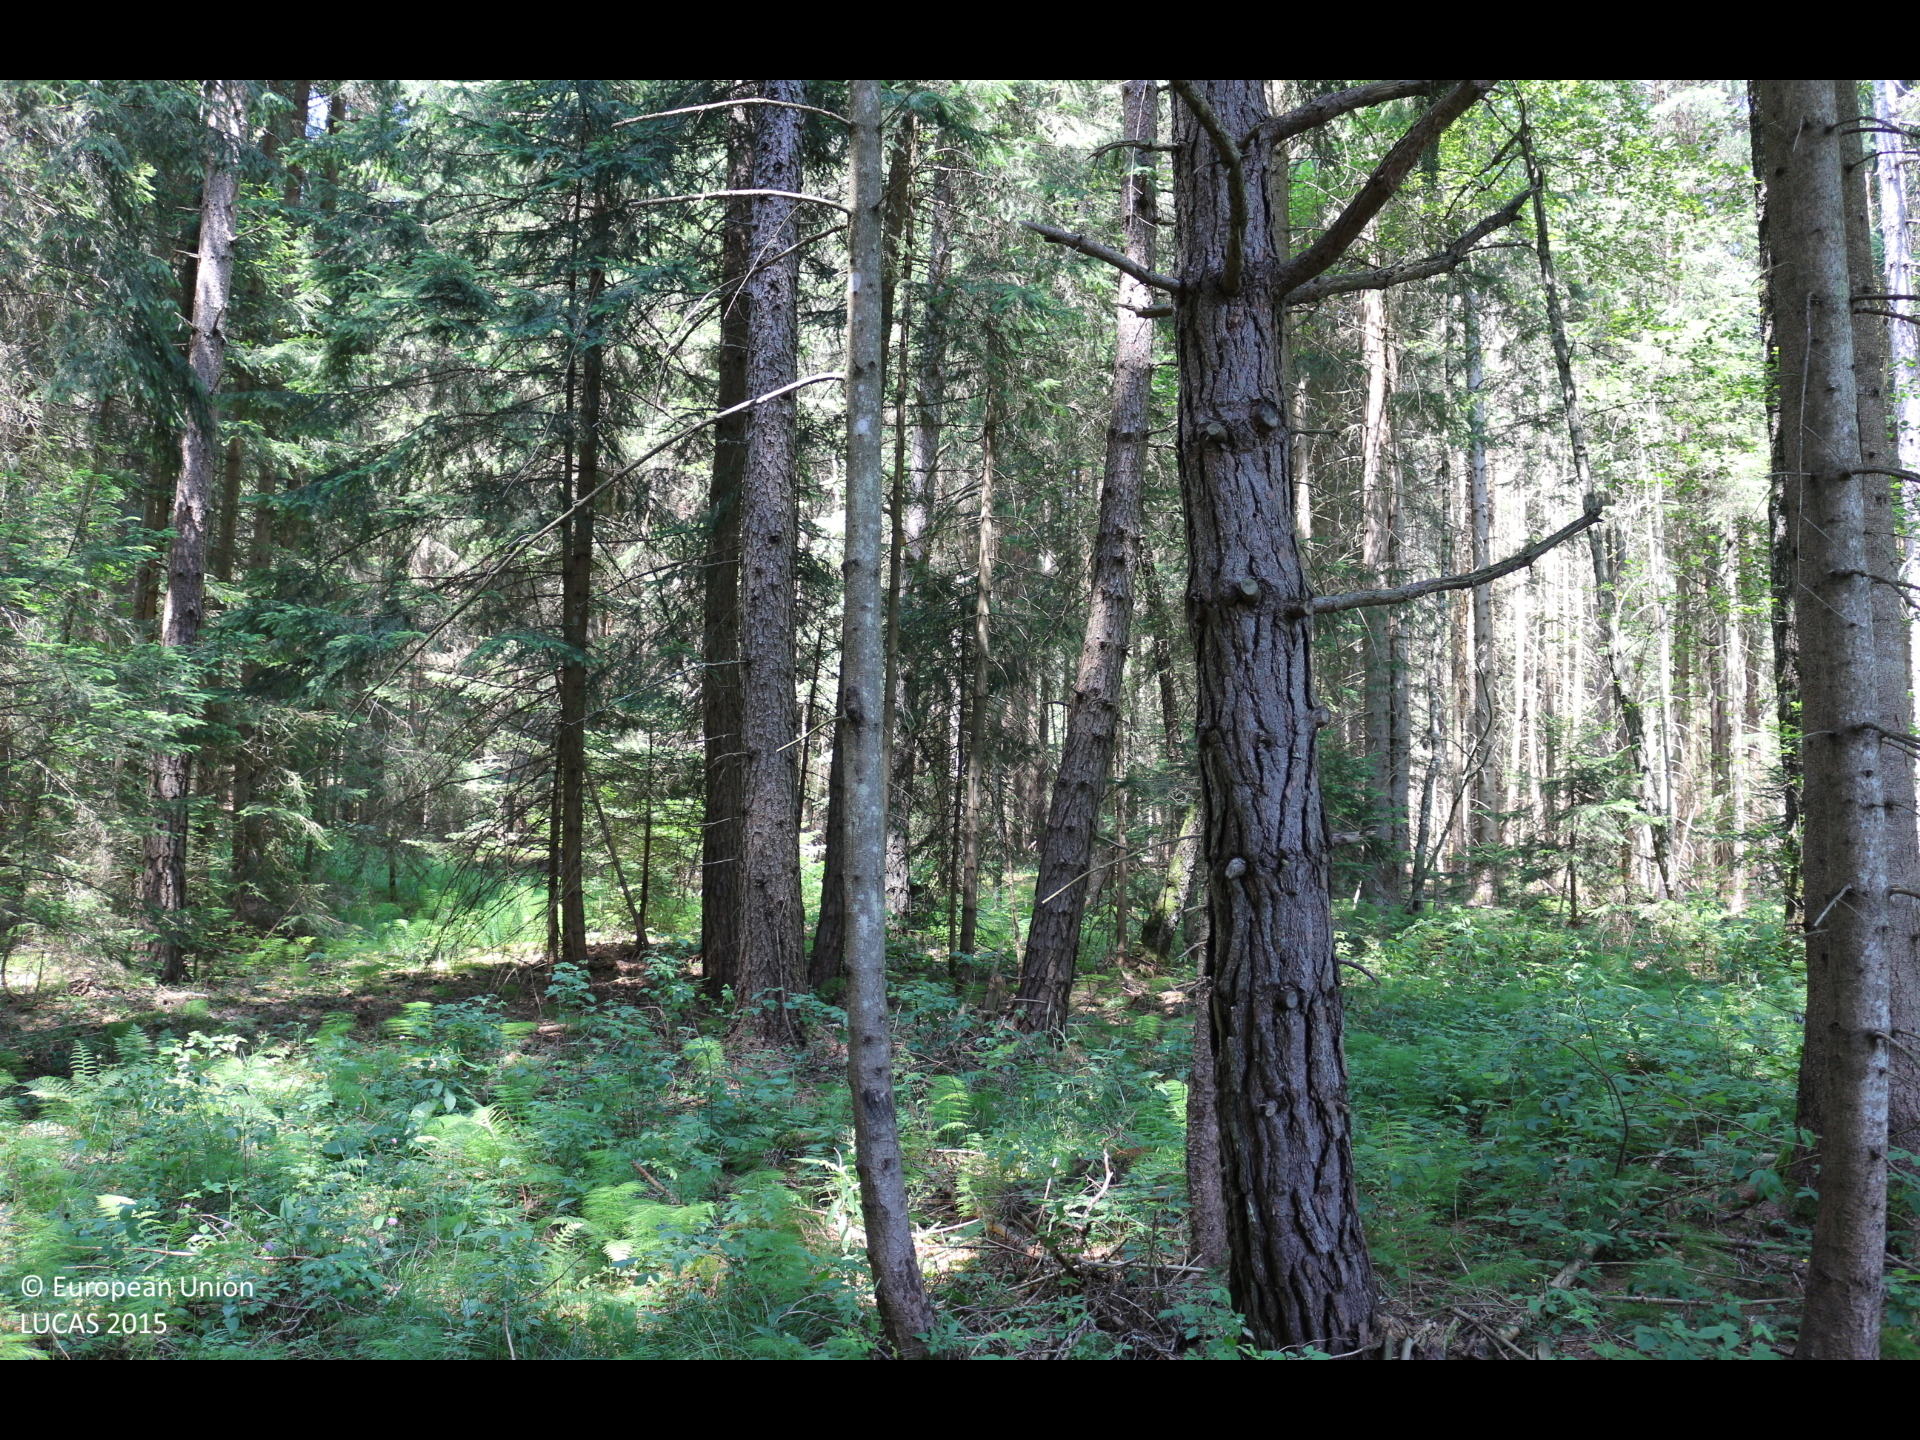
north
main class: Woodland
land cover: Spruce dominated coniferous woodland
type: alpine coniferous forest
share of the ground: > 75 %
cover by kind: coniferous forest trees 95 %, broadleaved forest trees 5 %
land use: Forestry
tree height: > 5 m
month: July
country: AT
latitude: 46.7796
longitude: 14.0447
